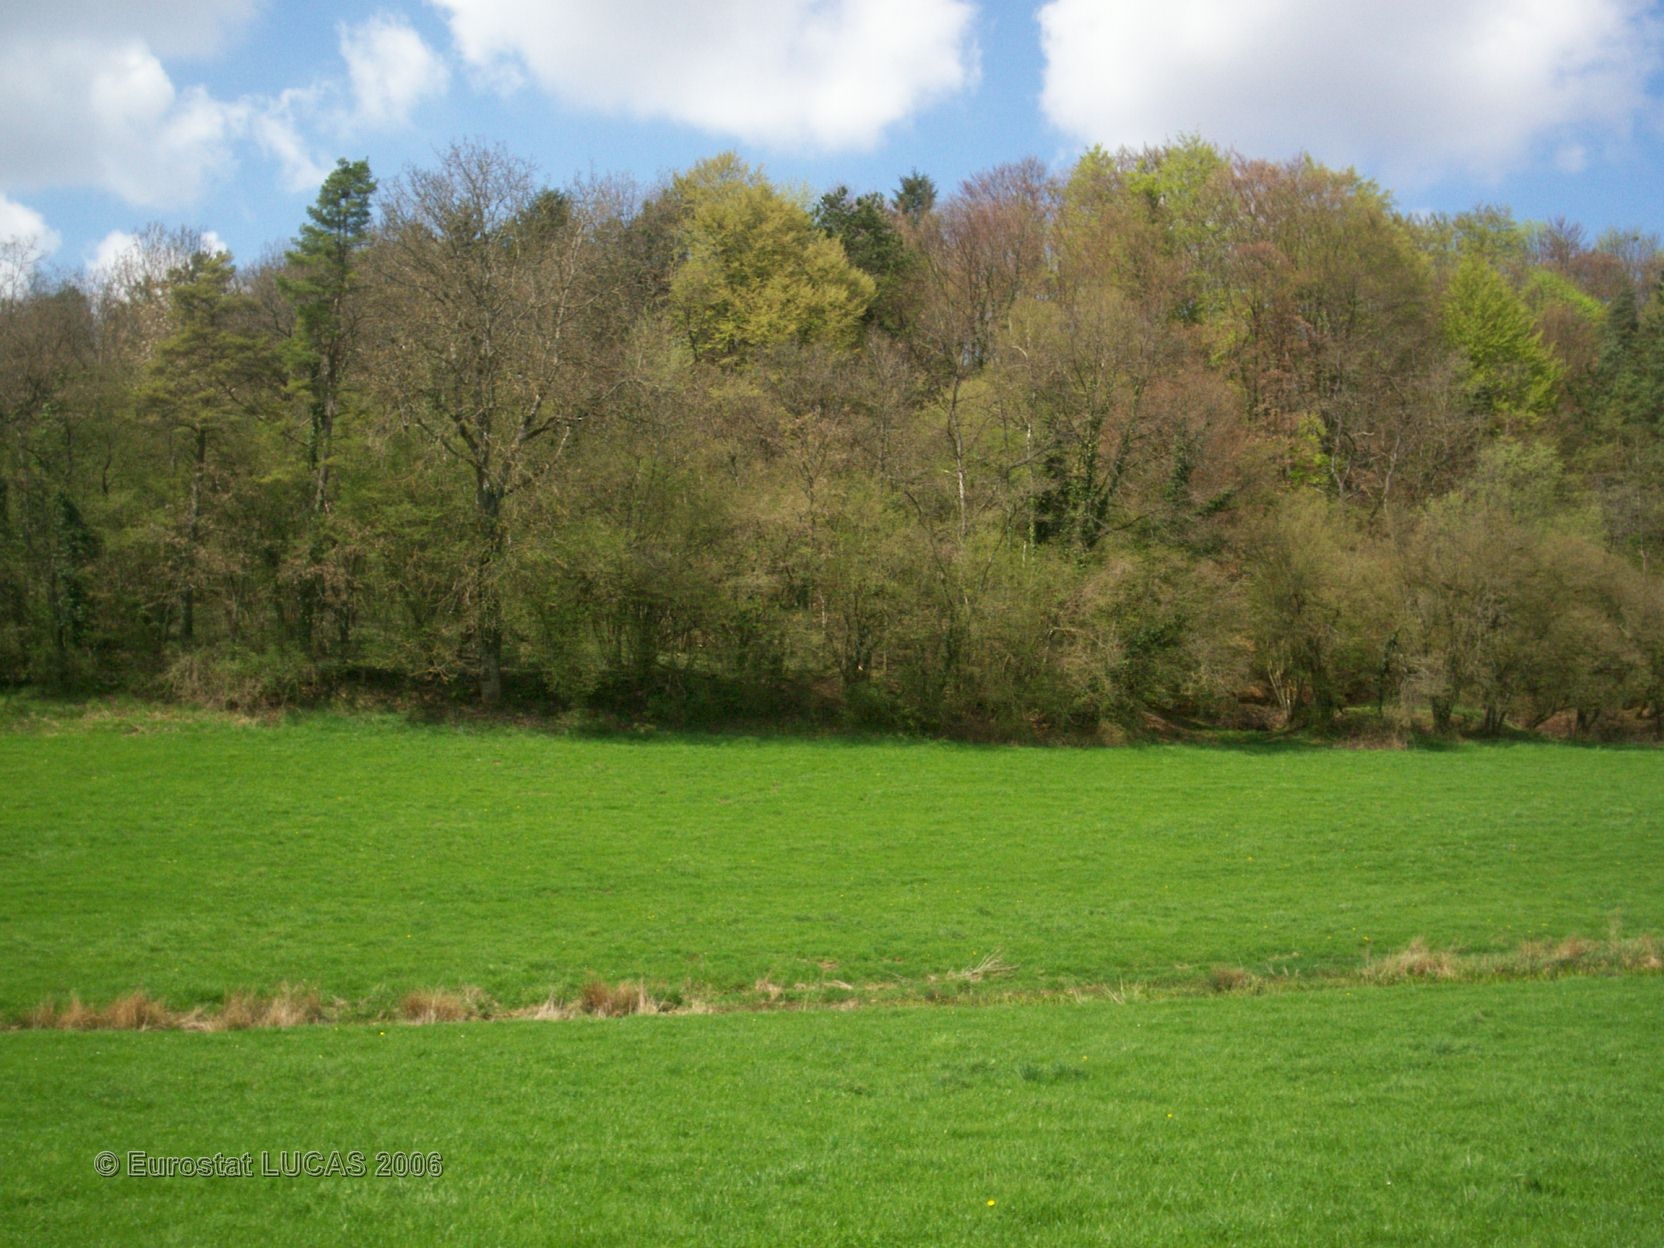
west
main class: Grassland
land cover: Grassland without tree/shrub cover
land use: Agriculture (excluding fallow land and kitchen gardens)
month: April
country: FR
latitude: 48.0497
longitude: 5.2639
